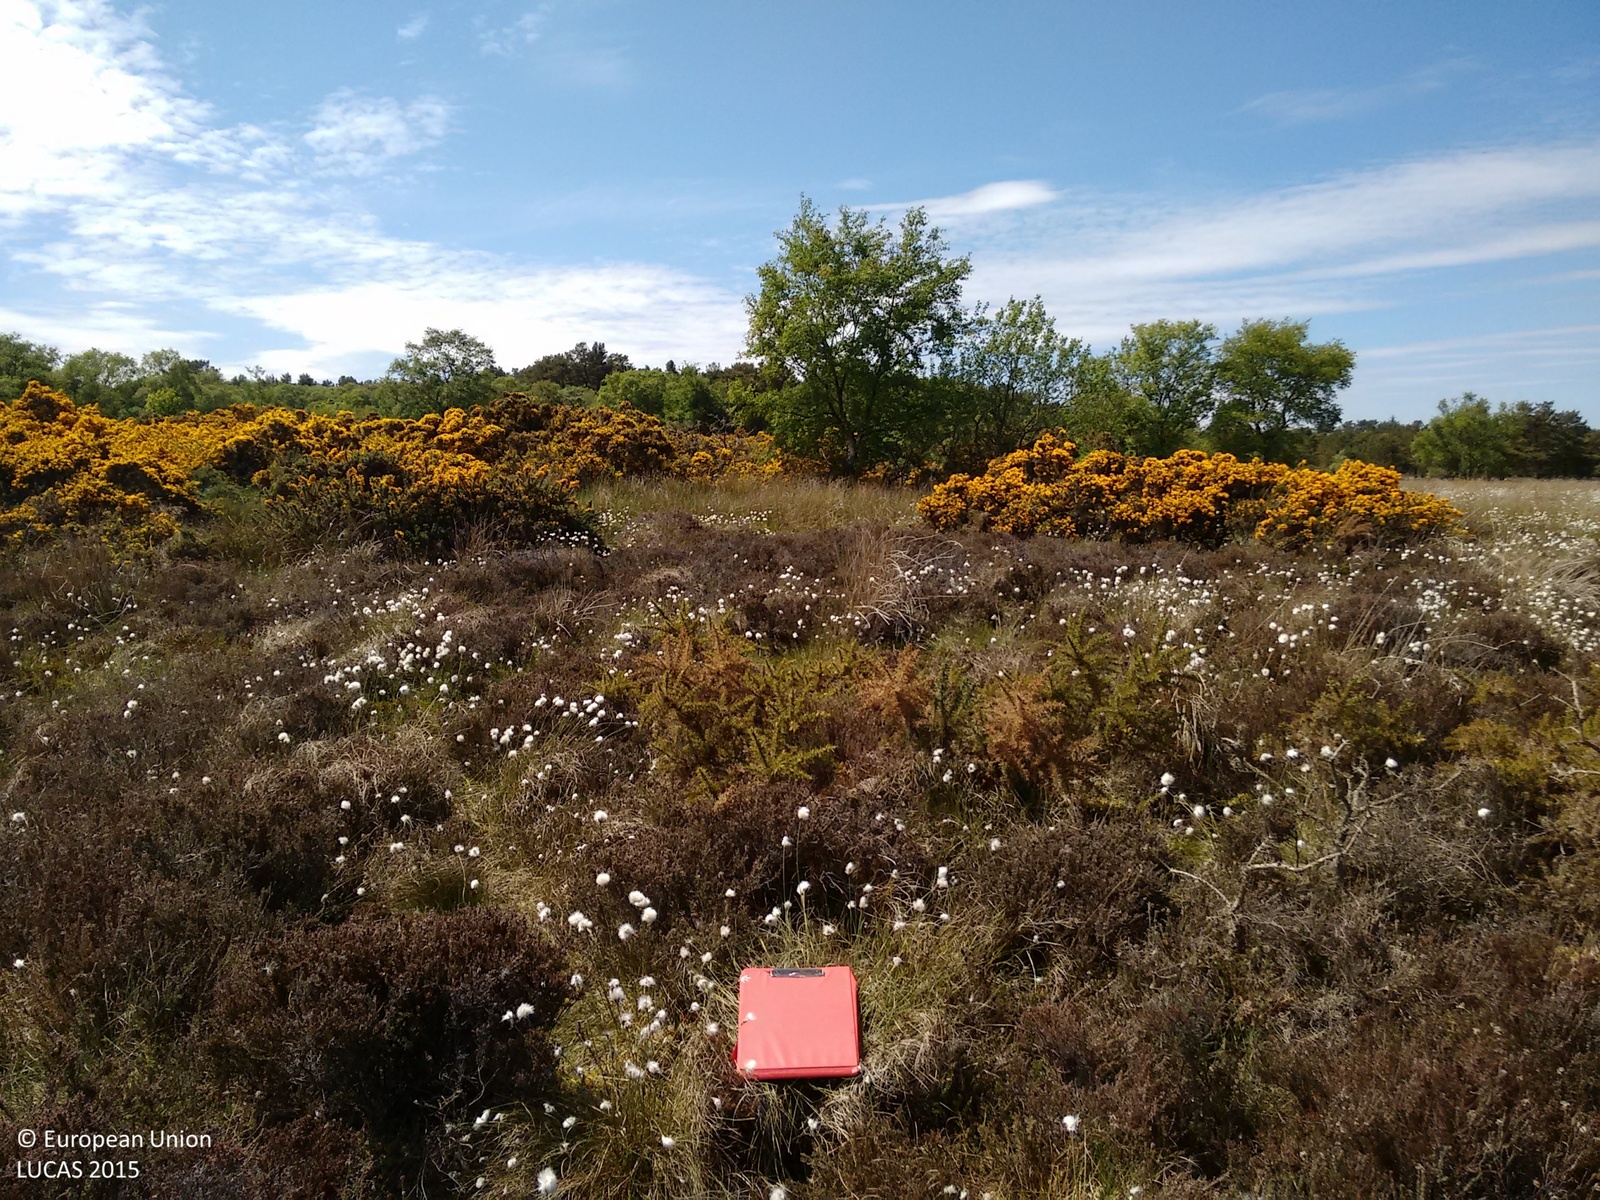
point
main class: Shrubland
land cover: Shrubland without tree cover
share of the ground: > 75 %
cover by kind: shrubs 65 %, herbaceous plants 20 %, lichens and mosses 15 %
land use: Semi-natural and natural areas not in use
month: June
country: GB
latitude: 57.0036
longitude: -2.2177
